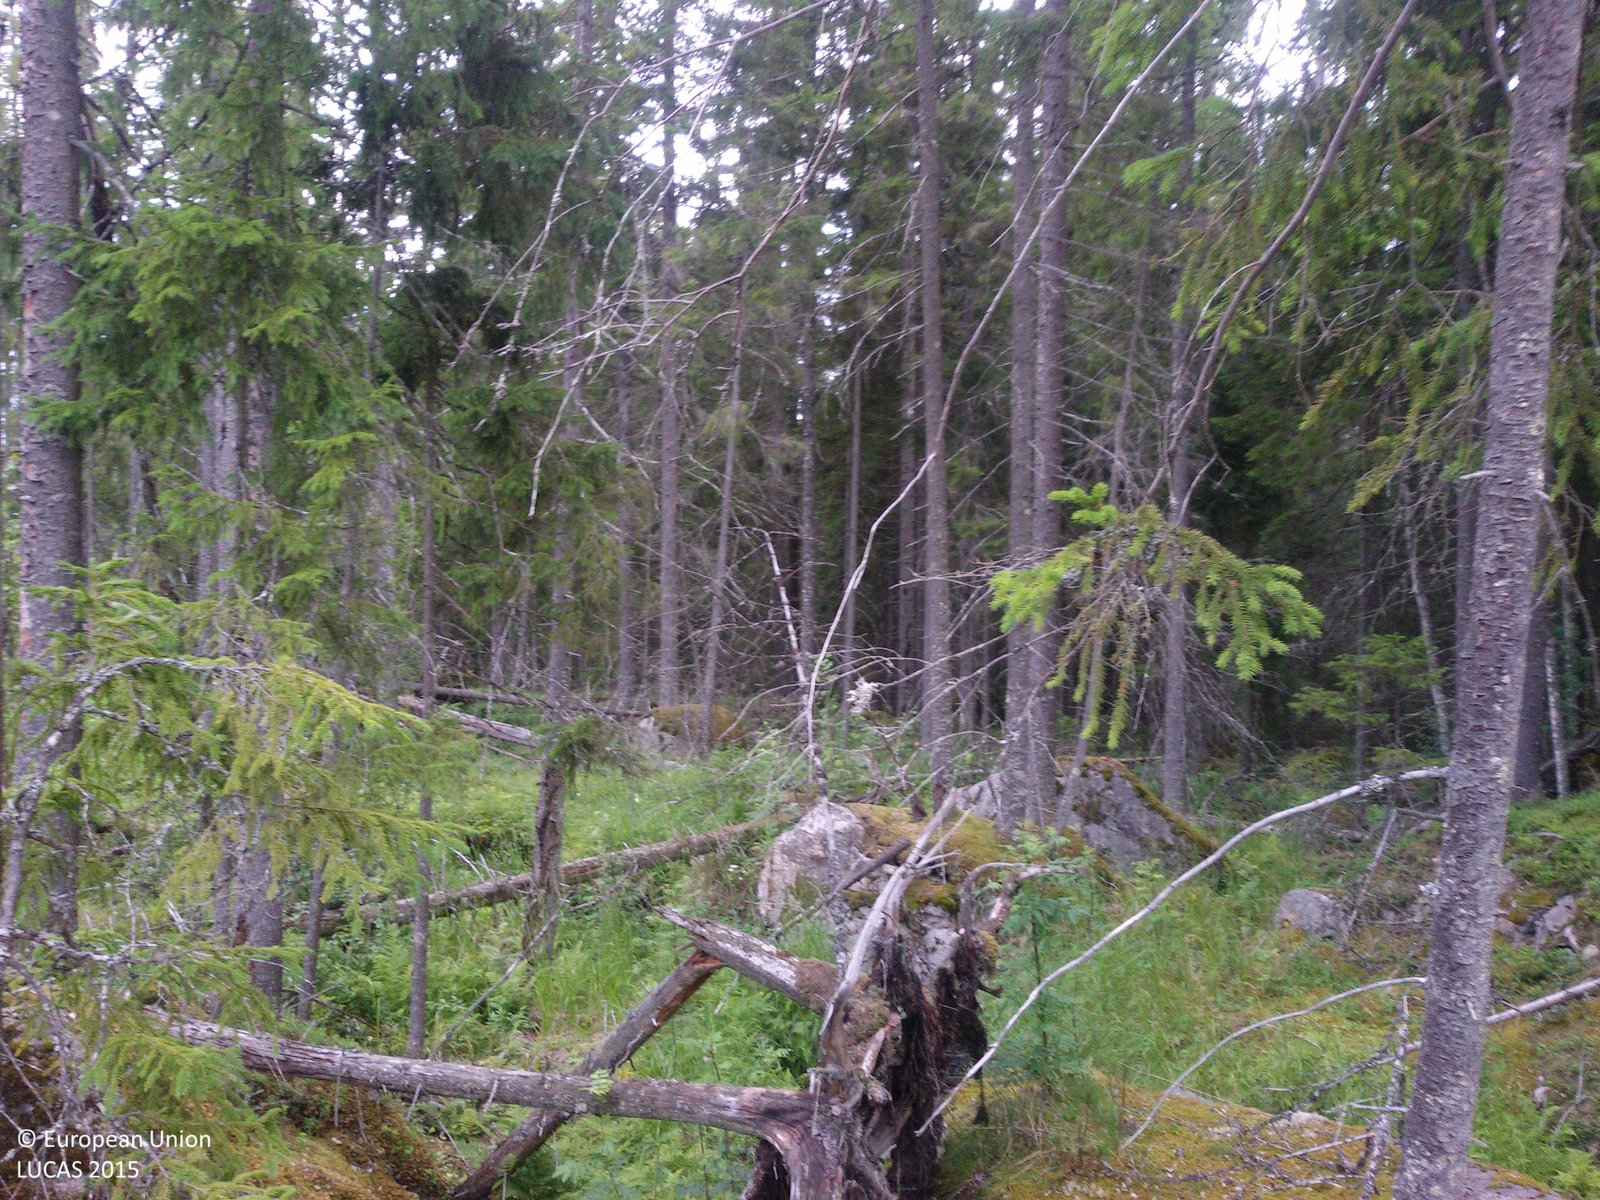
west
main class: Woodland
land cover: Spruce dominated coniferous woodland
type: boreal forest
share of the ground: 50 - 75 %
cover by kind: coniferous forest trees 75 %, shrubs 15 %, herbaceous plants 10 %
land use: Forestry
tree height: > 5 m
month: July
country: SE
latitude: 60.4008
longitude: 14.9431
